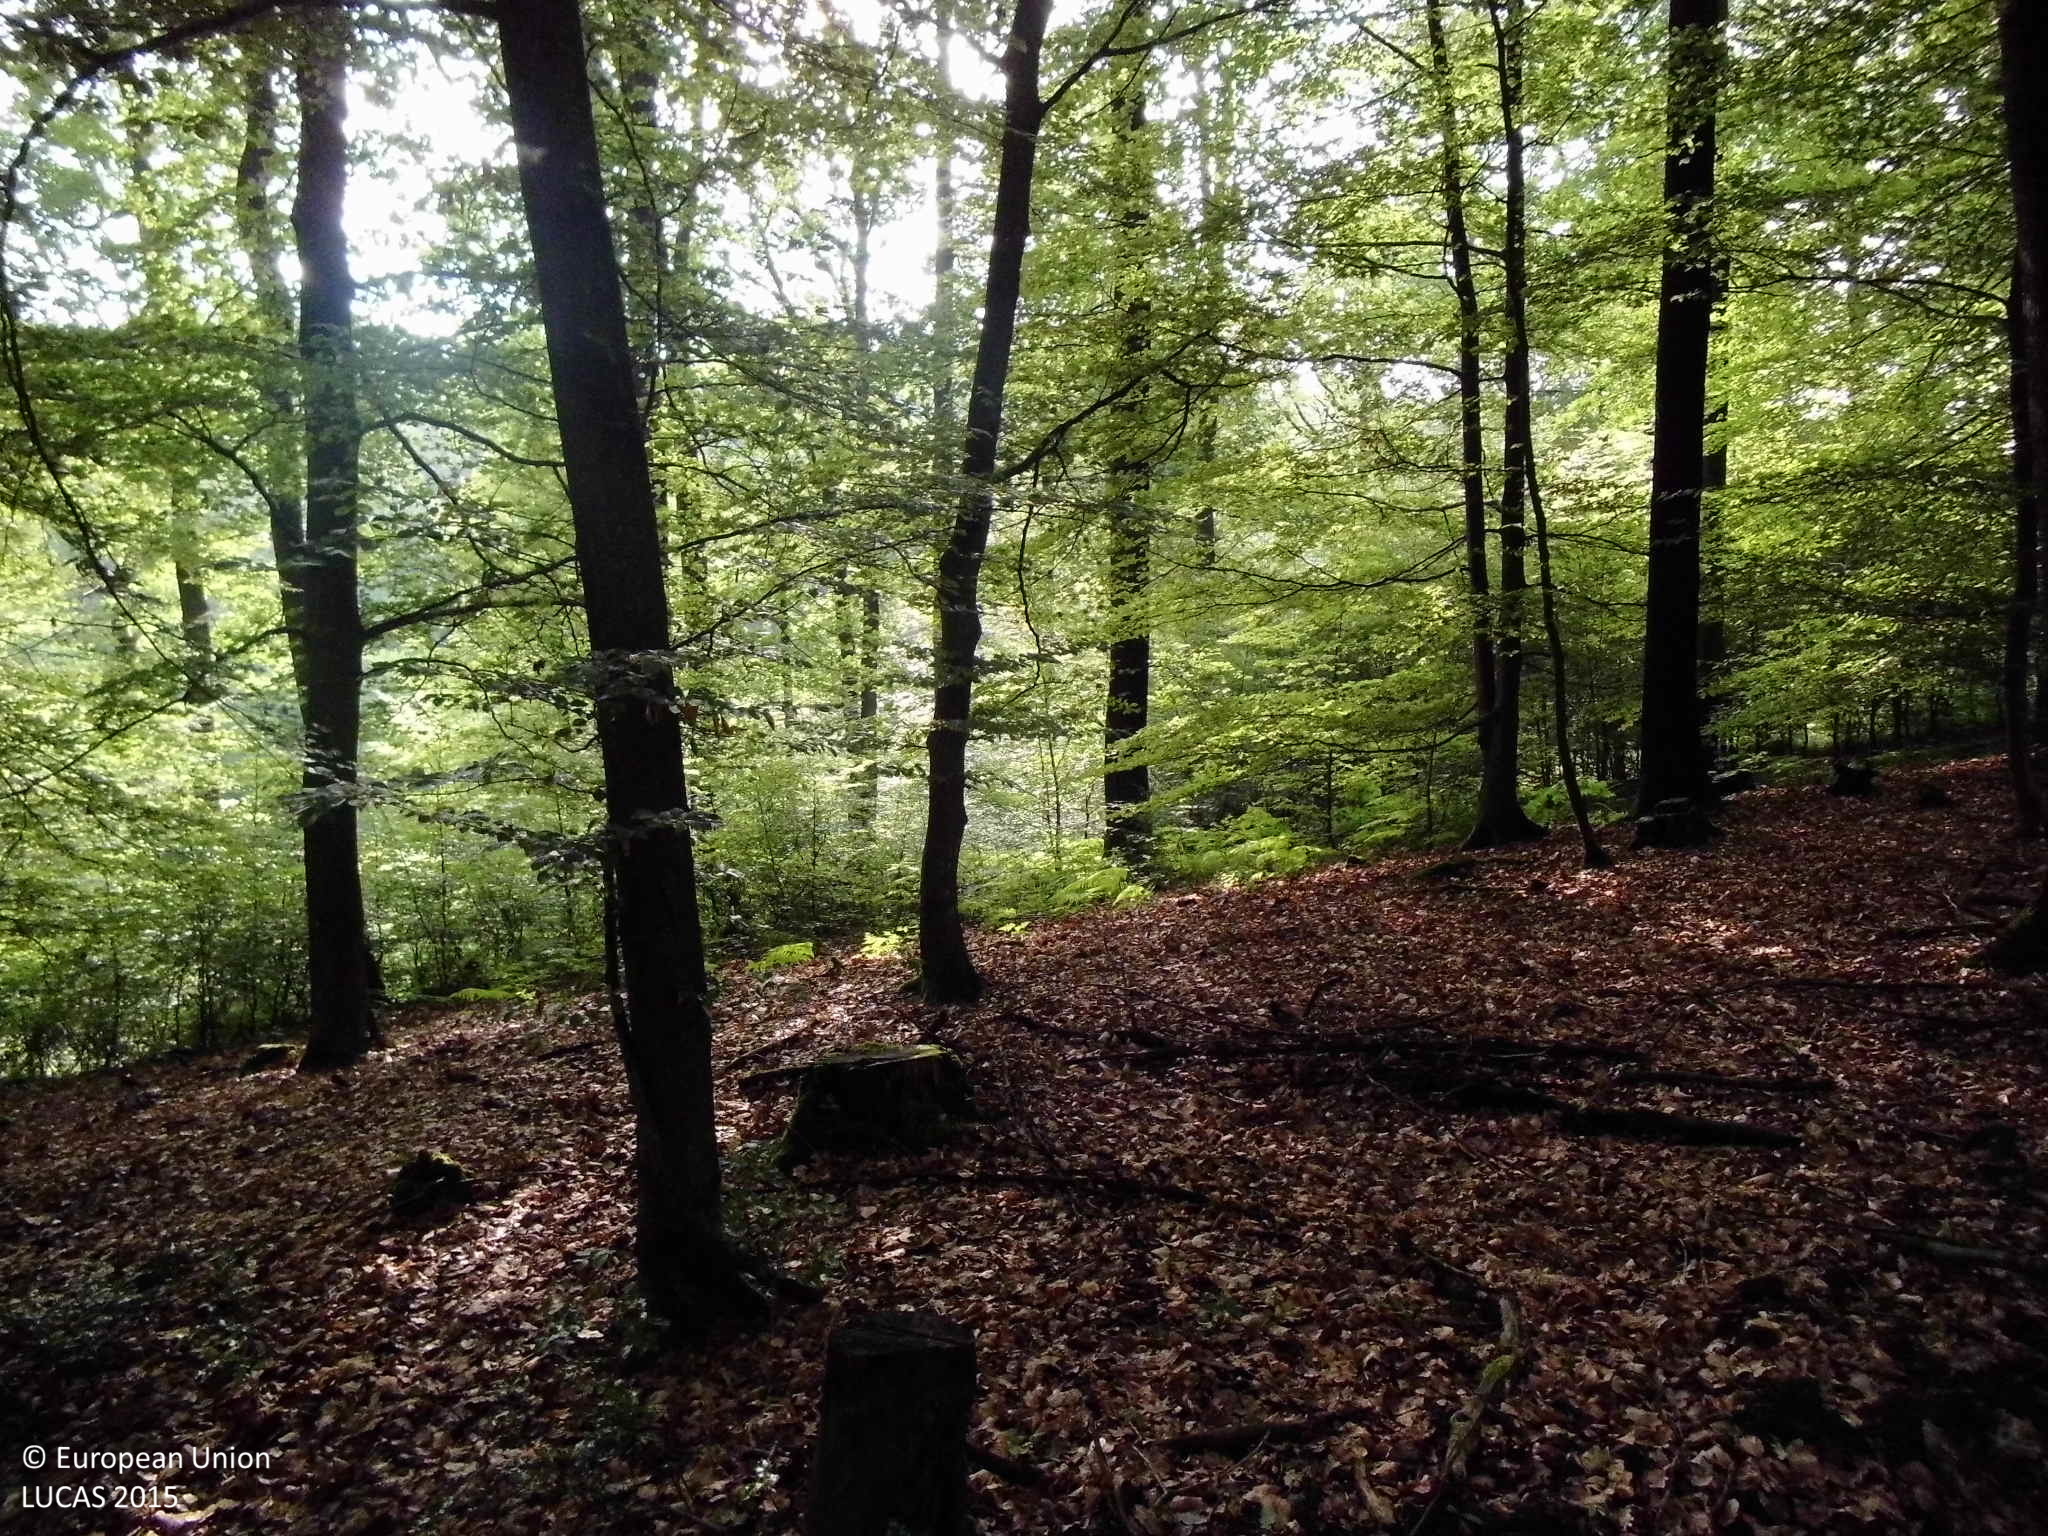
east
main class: Woodland
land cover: Broadleaved woodland
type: mesophytic deciduous forest
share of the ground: > 75 %
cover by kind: broadleaved forest trees 95 %, unconsolidated bare surface 5 %
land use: Forestry
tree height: > 5 m
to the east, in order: Broadleaved woodland; Shrubland without tree cover; Rivers and streams; Grassland with sparse tree/shrub cover; Spruce dominated coniferous woodland; Shruby margins; Tracks; Broadleaved woodland; Other mixed woodland
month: June
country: DE
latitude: 50.8209
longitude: 7.4309
